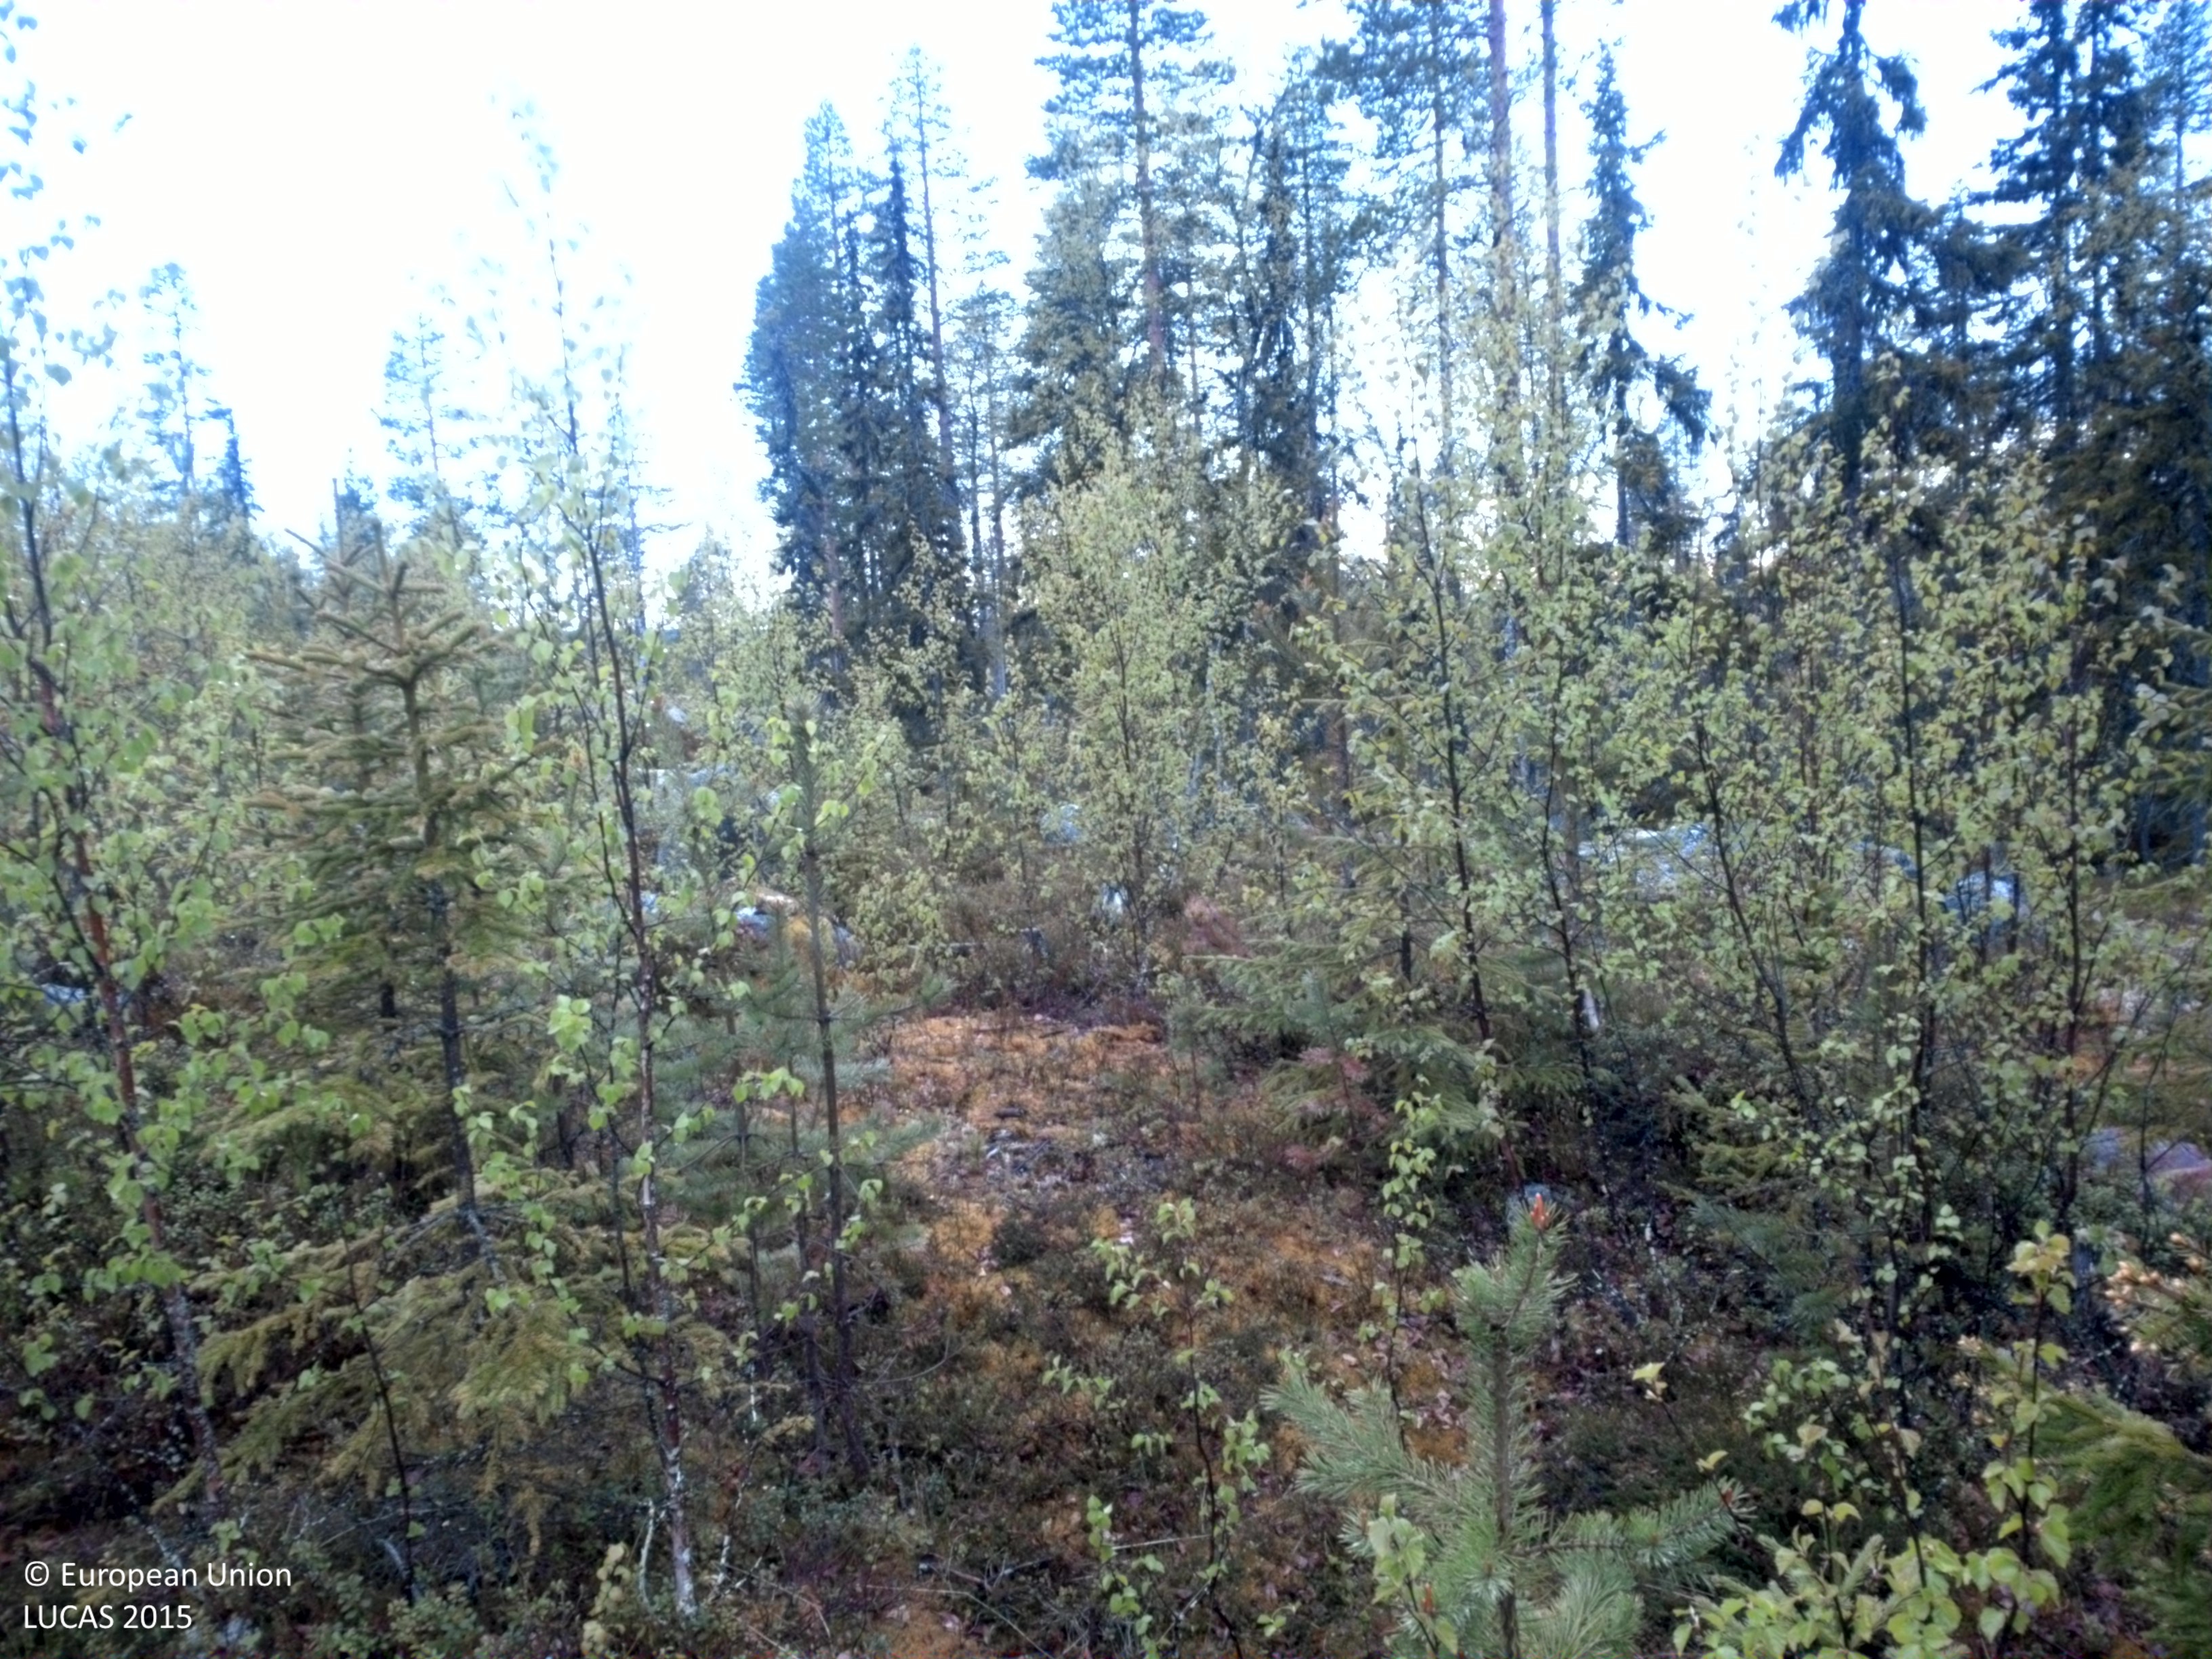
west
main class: Woodland
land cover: Pine dominated mixed woodland
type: boreal forest
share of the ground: 25 - 50 %
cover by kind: coniferous forest trees 30 %, herbaceous plants 25 %, broadleaved forest trees 15 %, lichens and mosses 15 %, unconsolidated bare surface 10 %, shrubs 5 %
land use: Forestry
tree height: < 5 m
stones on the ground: 25 - 50 %
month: June
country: SE
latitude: 64.4420
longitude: 17.4256
